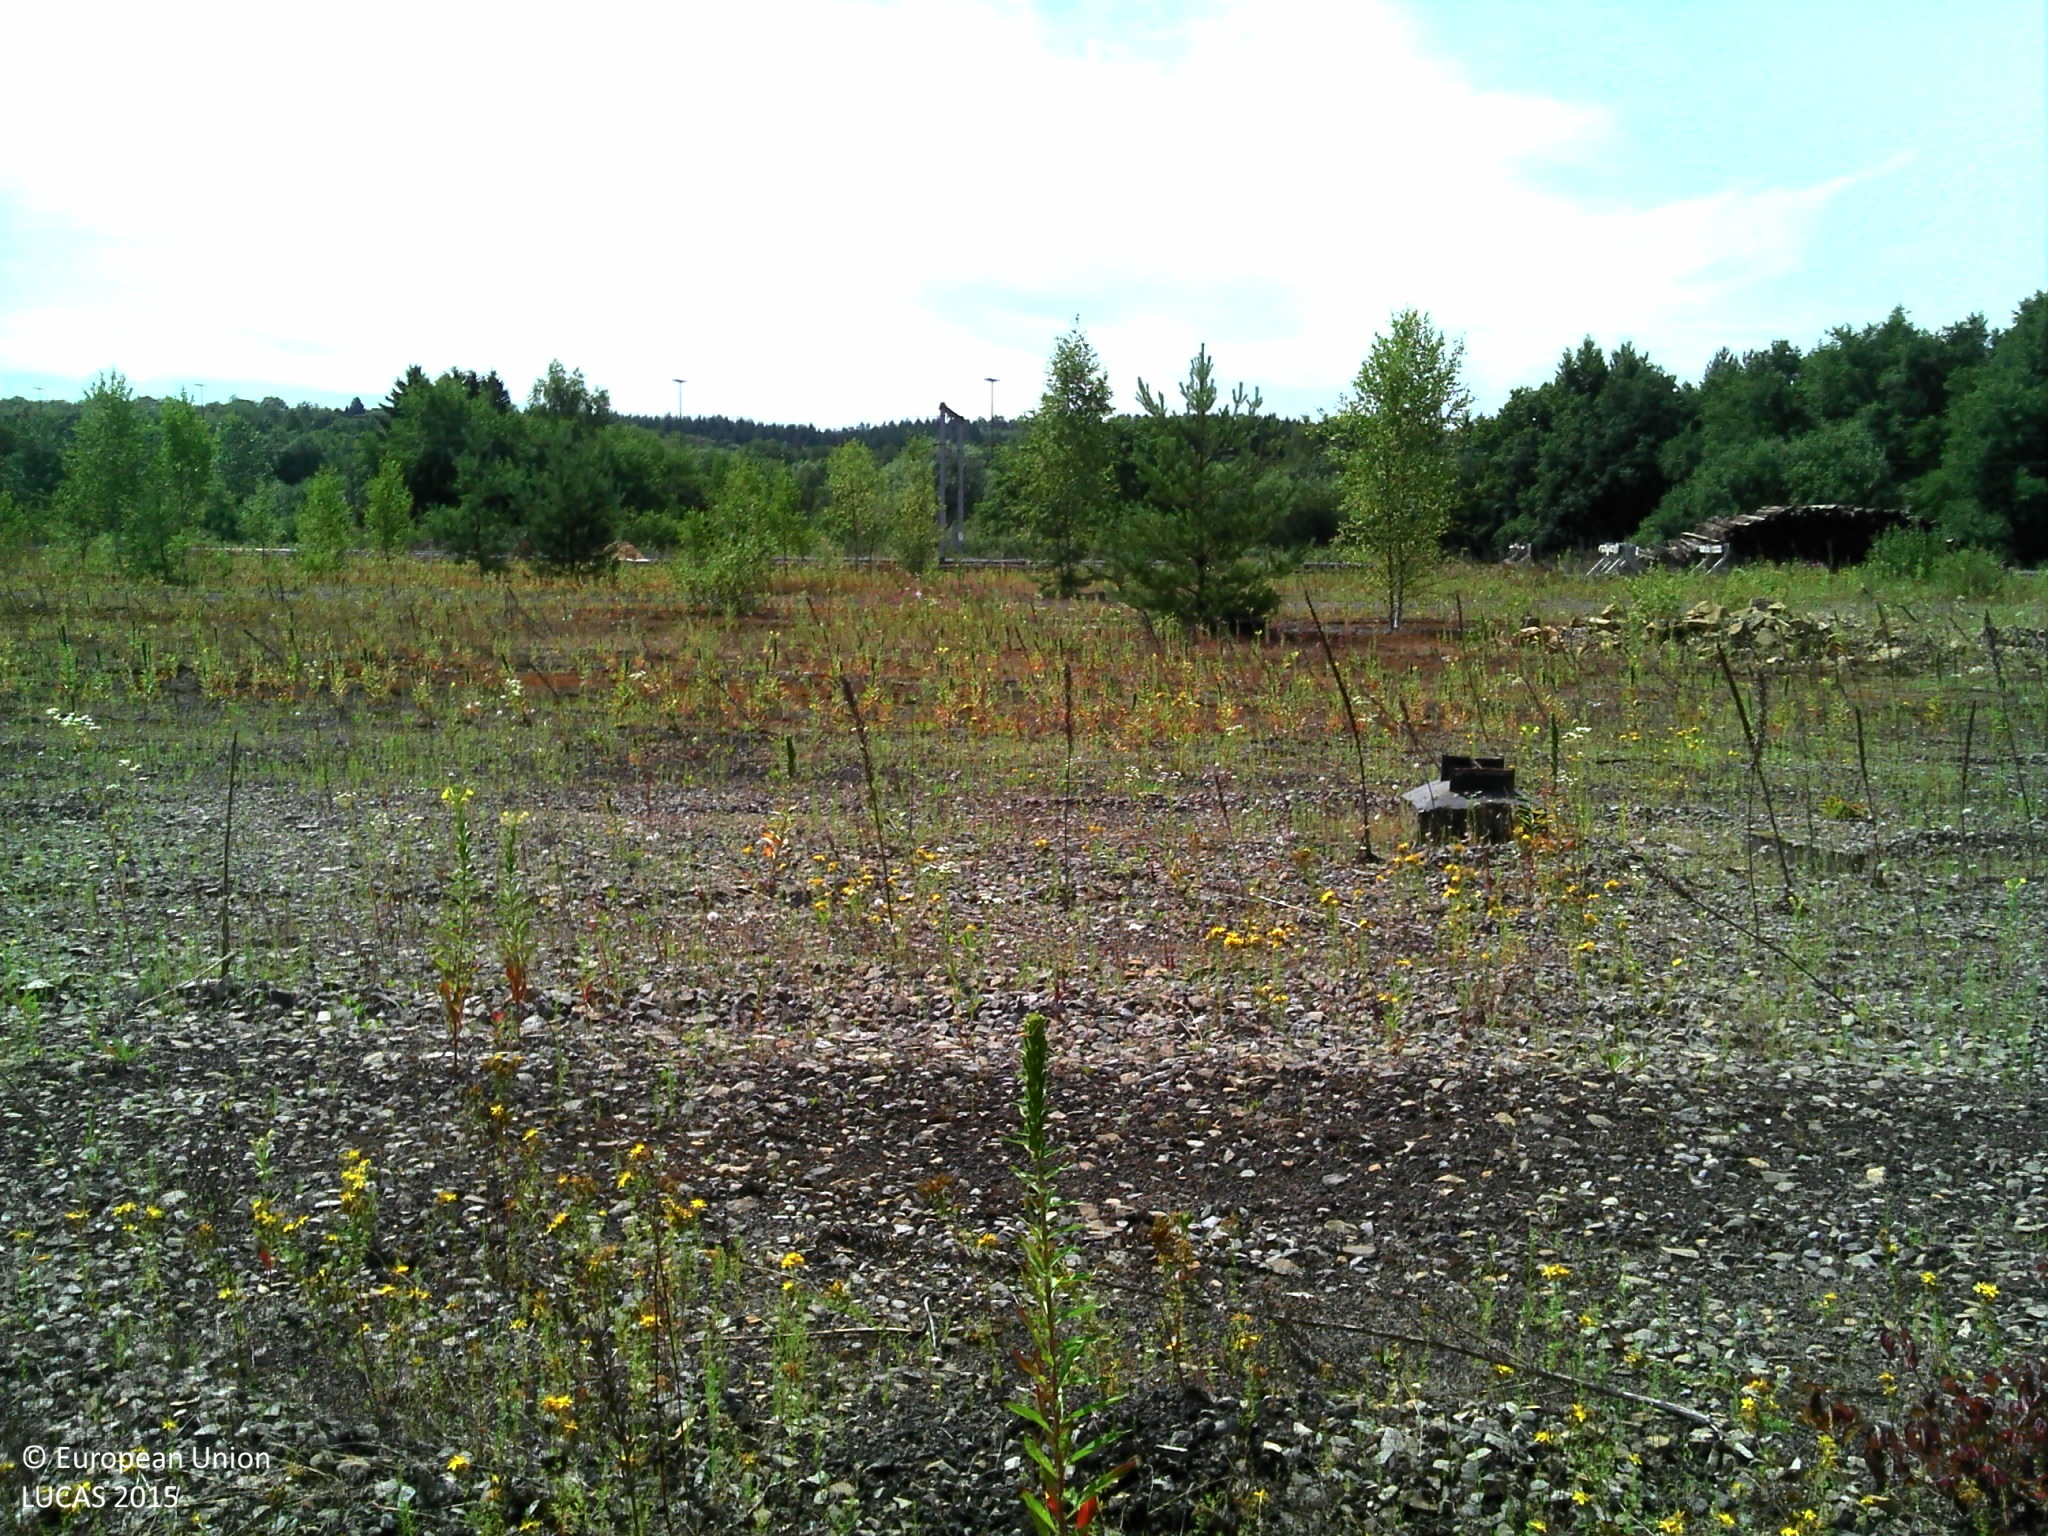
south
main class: Grassland
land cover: Spontaneously vegetated surfaces
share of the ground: 50 - 75 %
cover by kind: herbaceous plants 55 %, unconsolidated bare surface 40 %, shrubs 5 %
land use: Semi-natural and natural areas not in use
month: July
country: BE
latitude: 49.6906
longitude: 5.7432
